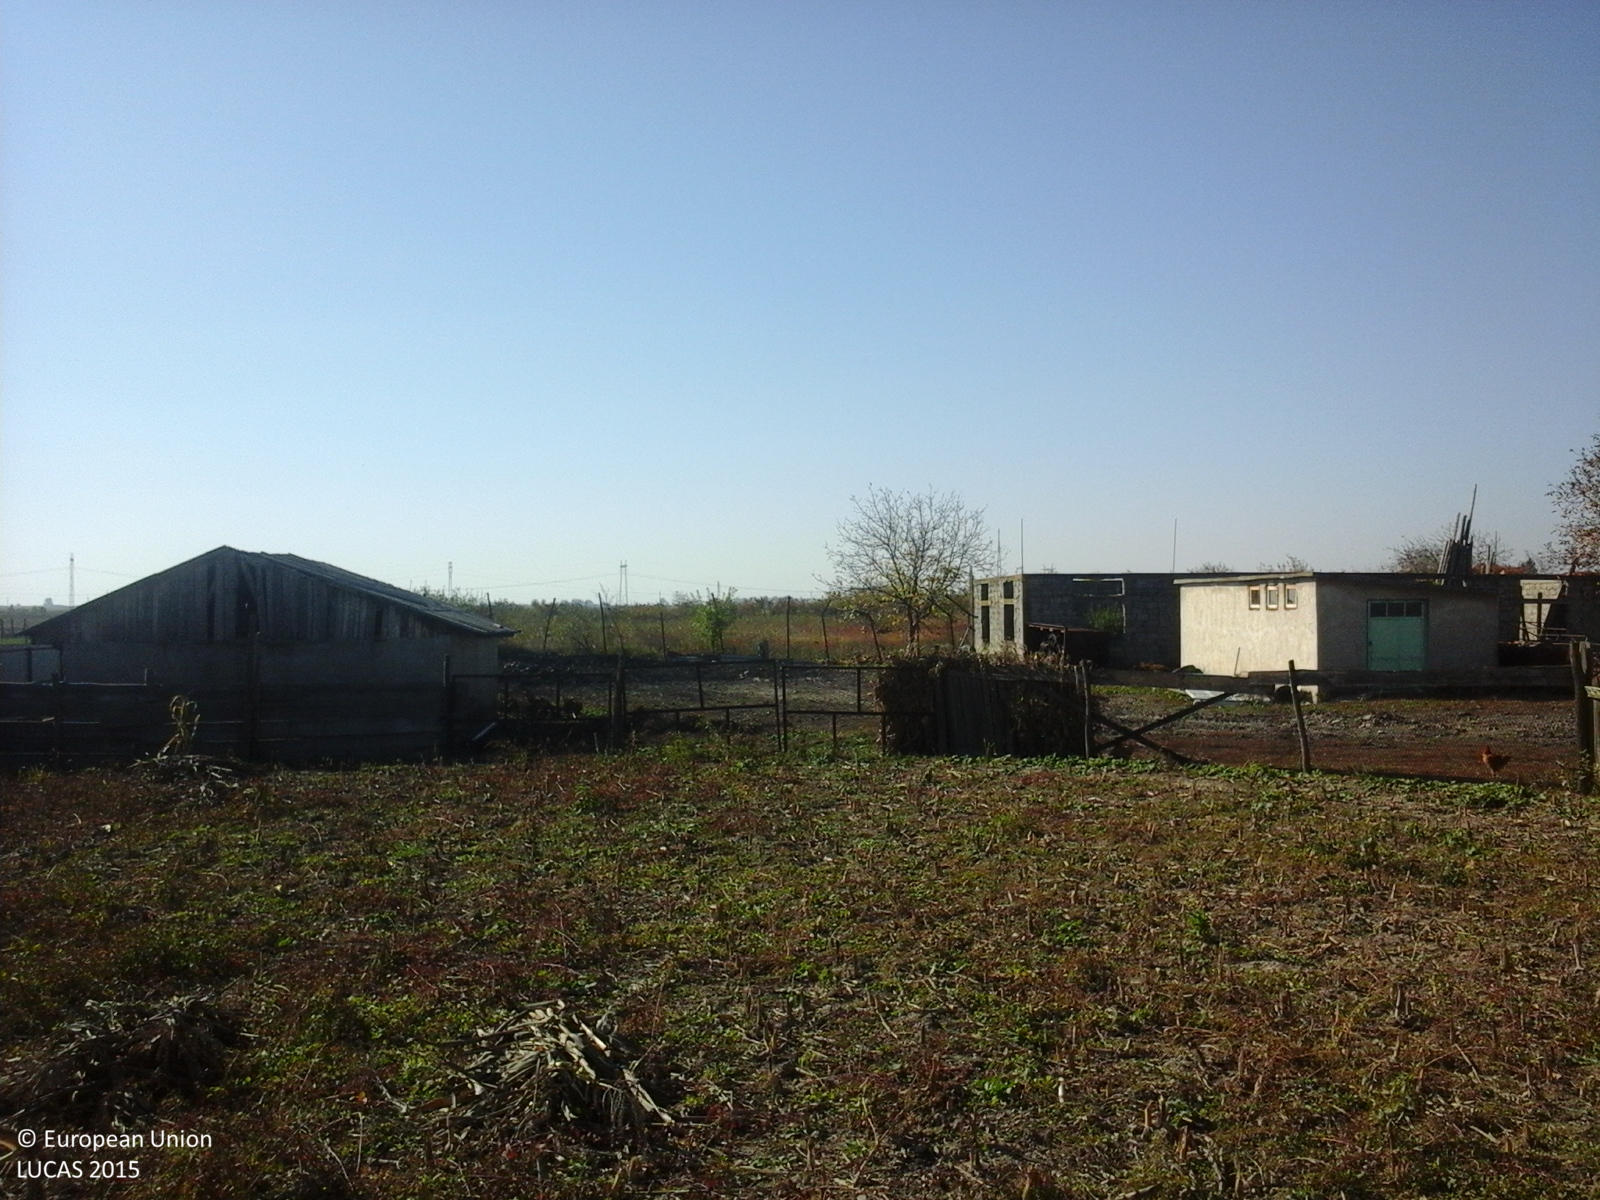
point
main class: Cropland
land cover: Maize
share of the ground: 25 - 50 %
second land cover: Spontaneously vegetated surfaces
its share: 25 - 50 %
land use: Kitchen garden
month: October
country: RO
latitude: 45.6673
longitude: 27.3903
